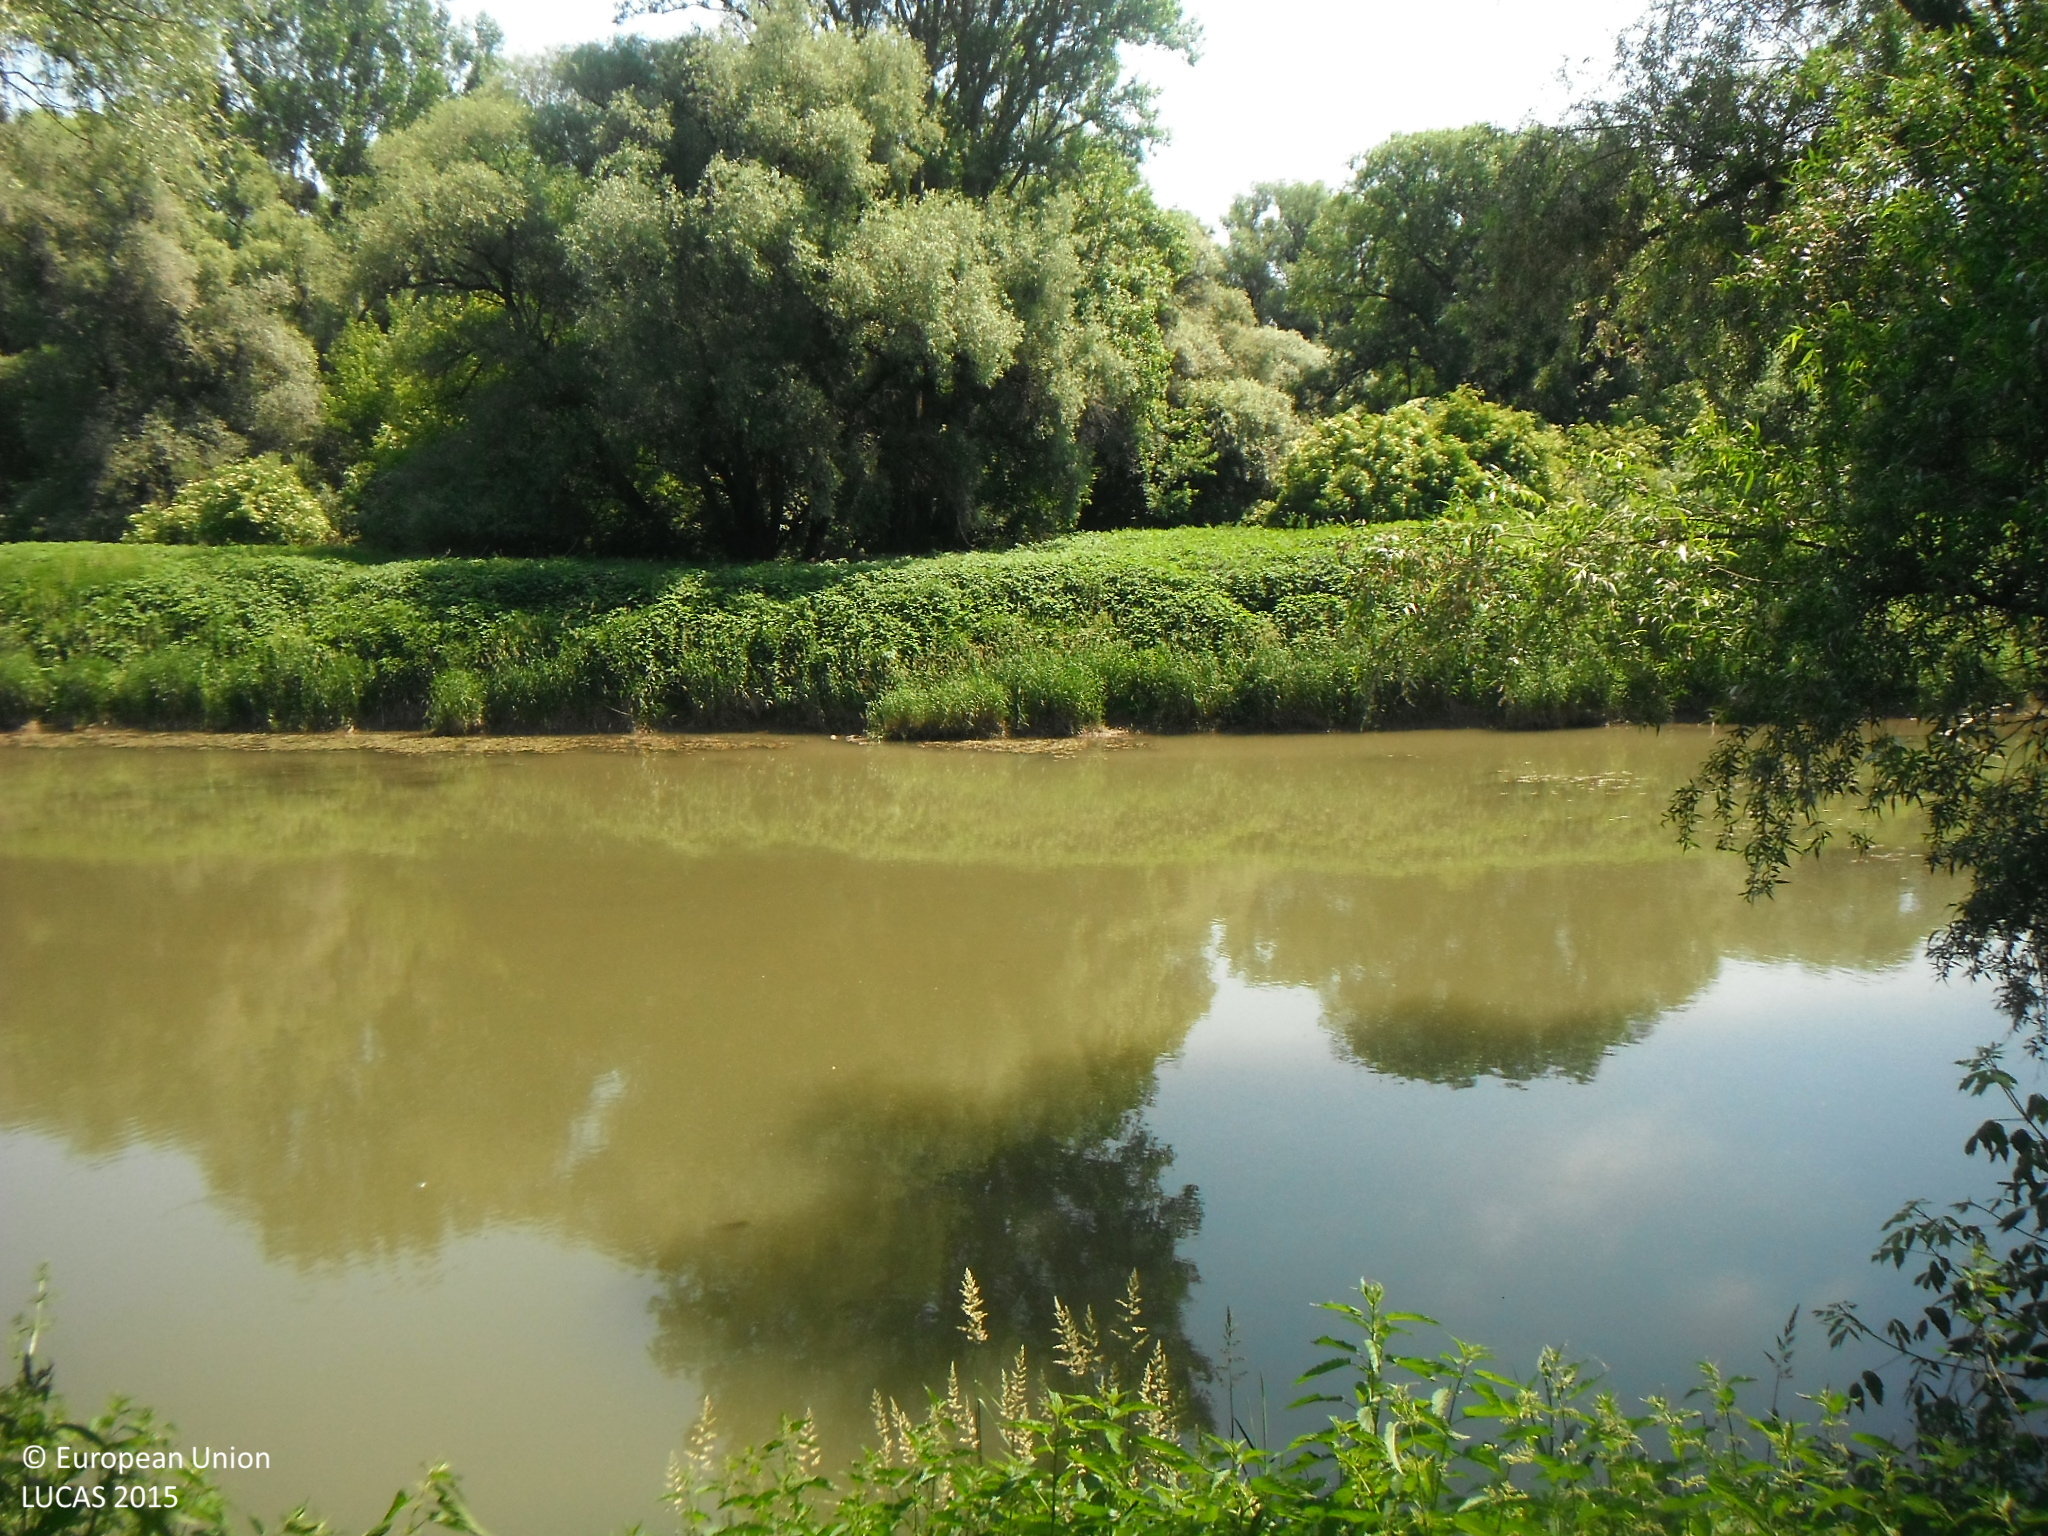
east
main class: Grassland
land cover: Spontaneously vegetated surfaces
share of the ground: > 75 %
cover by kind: herbaceous plants 95 %, shrubs 5 %
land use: Semi-natural and natural areas not in use
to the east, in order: Spontaneously vegetated surfaces; Broadleaved woodland
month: June
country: SK
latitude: 48.7966
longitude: 21.8833
